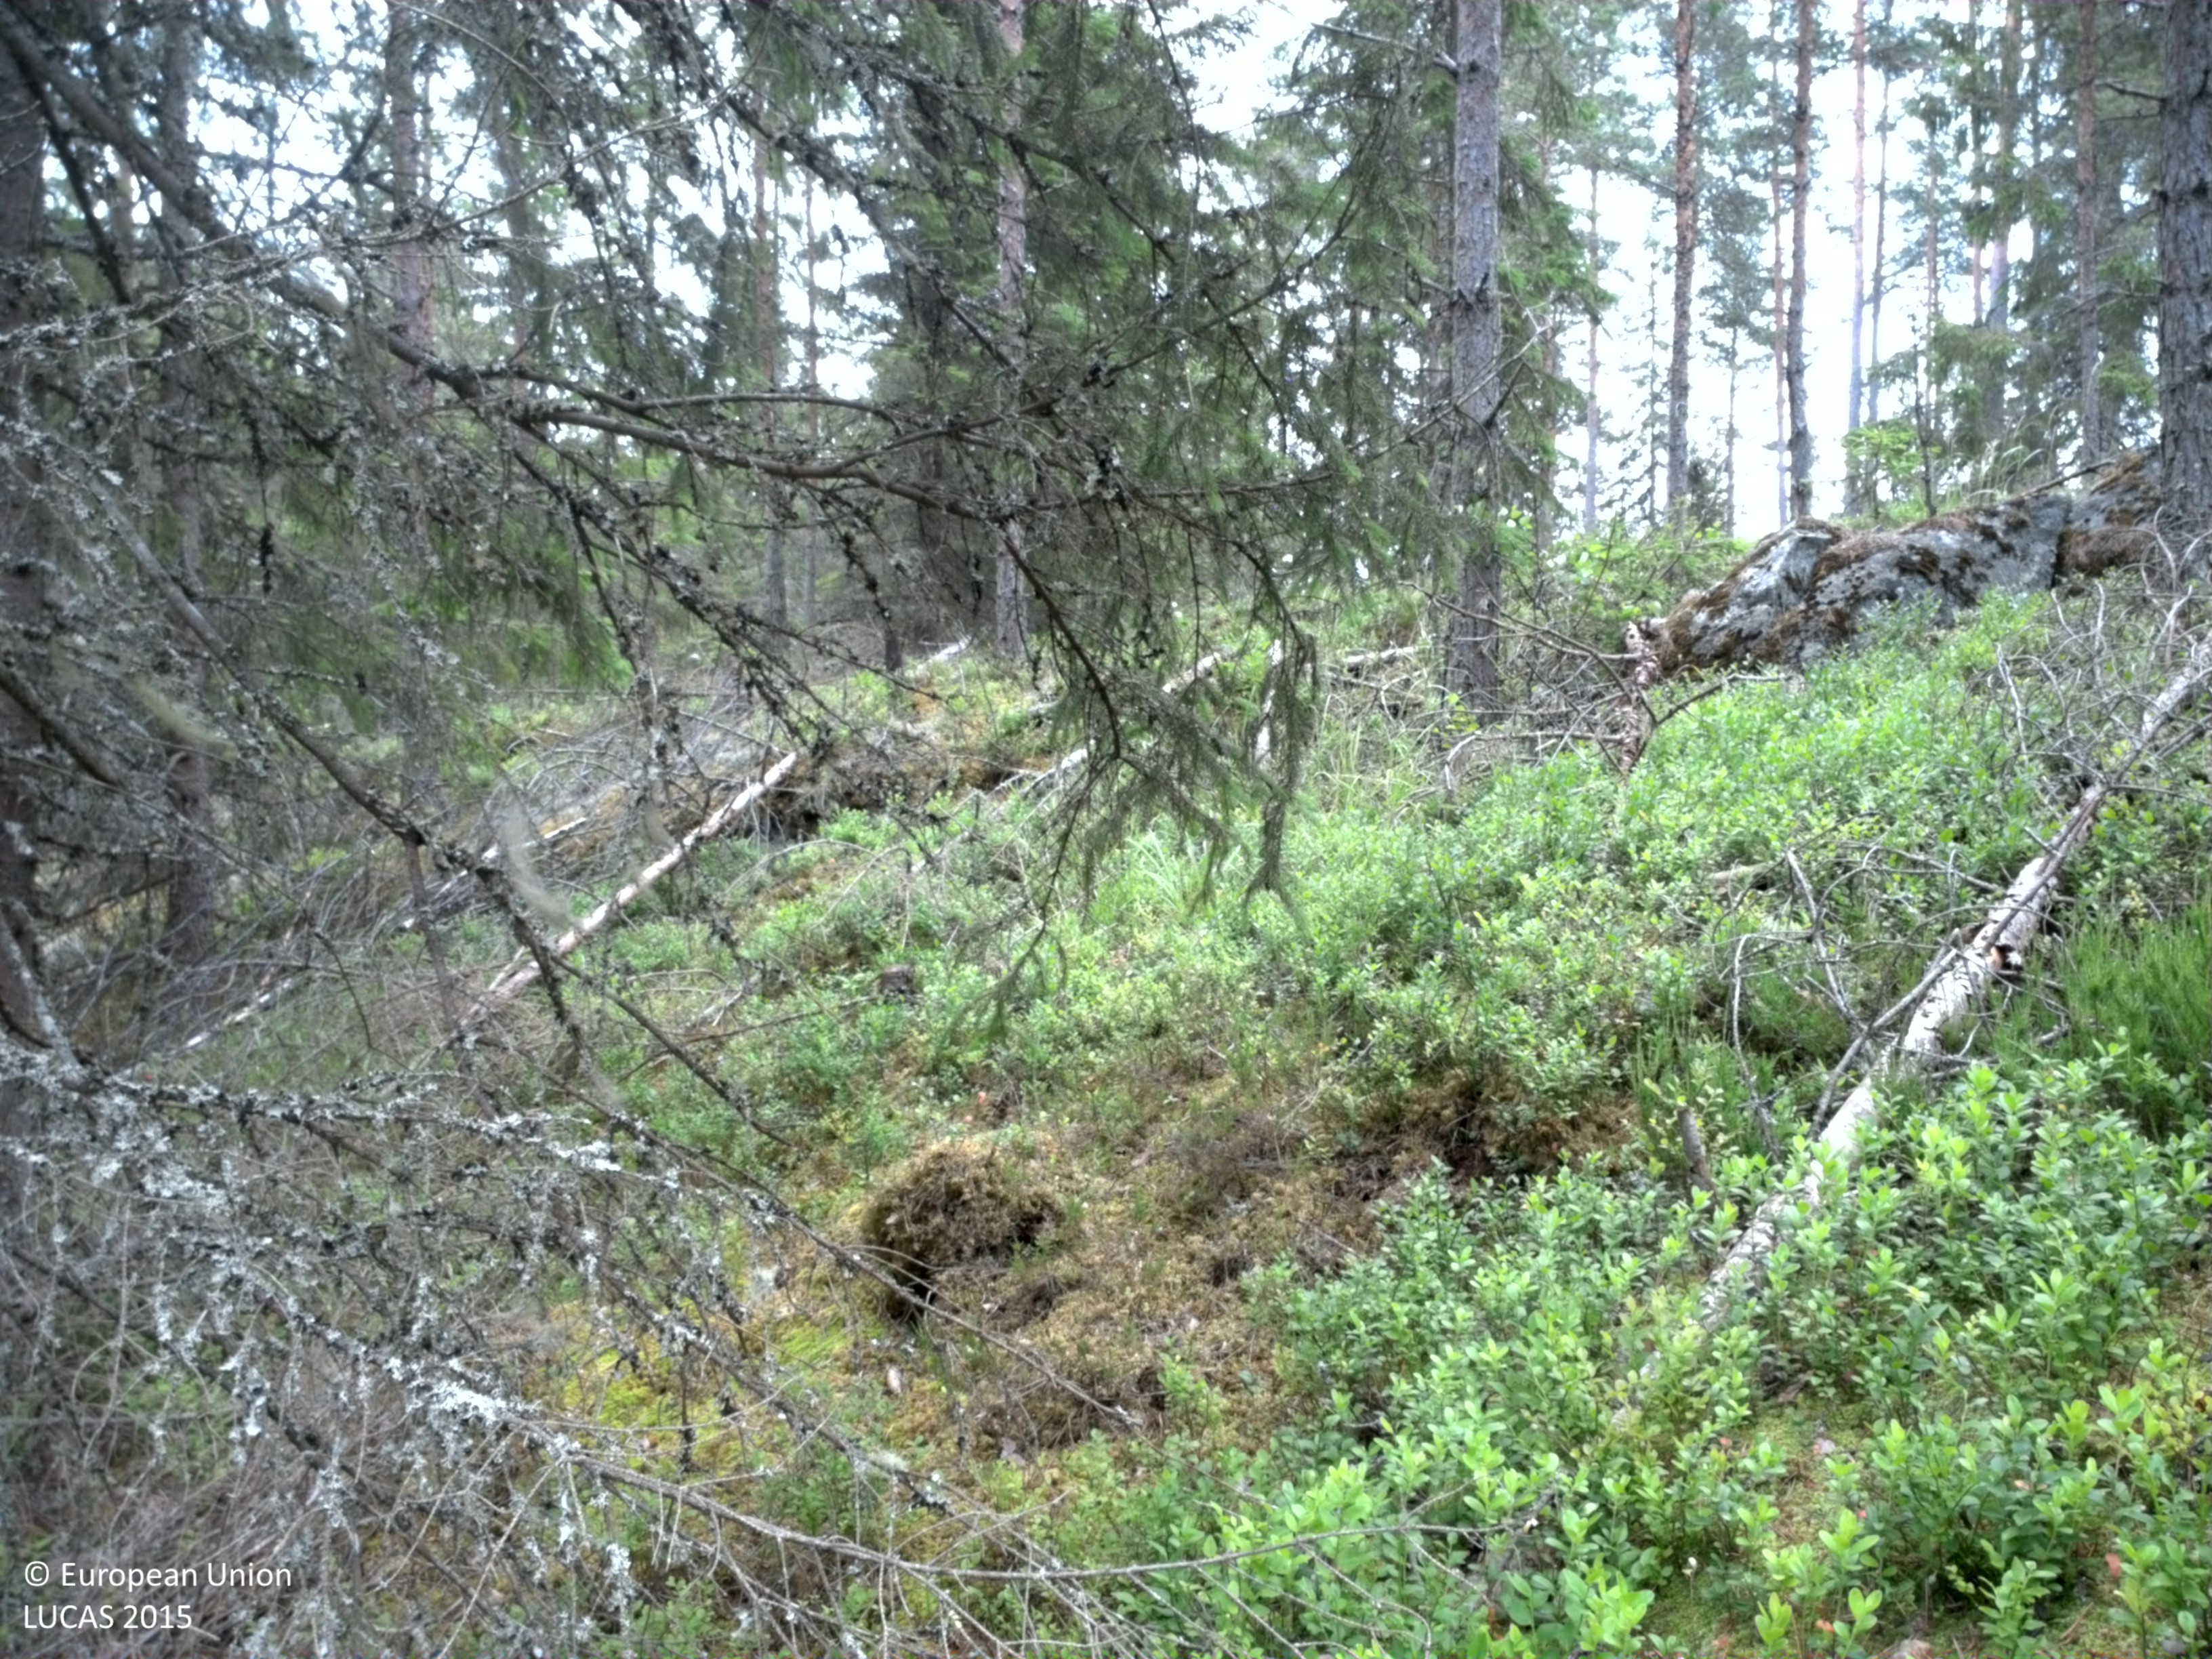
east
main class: Woodland
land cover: Pine dominated mixed woodland
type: boreal forest
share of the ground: 25 - 50 %
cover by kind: coniferous forest trees 35 %, shrubs 25 %, lichens and mosses 20 %, broadleaved forest trees 15 %, herbaceous plants 5 %
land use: Forestry
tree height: > 5 m
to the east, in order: Pine dominated mixed woodland; Tracks; Pine dominated mixed woodland; Pine dominated coniferous woodland; Pine dominated mixed woodland; Rivers and streams; Pine dominated mixed woodland; Tracks; Pine dominated coniferous woodland
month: July
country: SE
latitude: 59.6453
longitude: 11.9284
